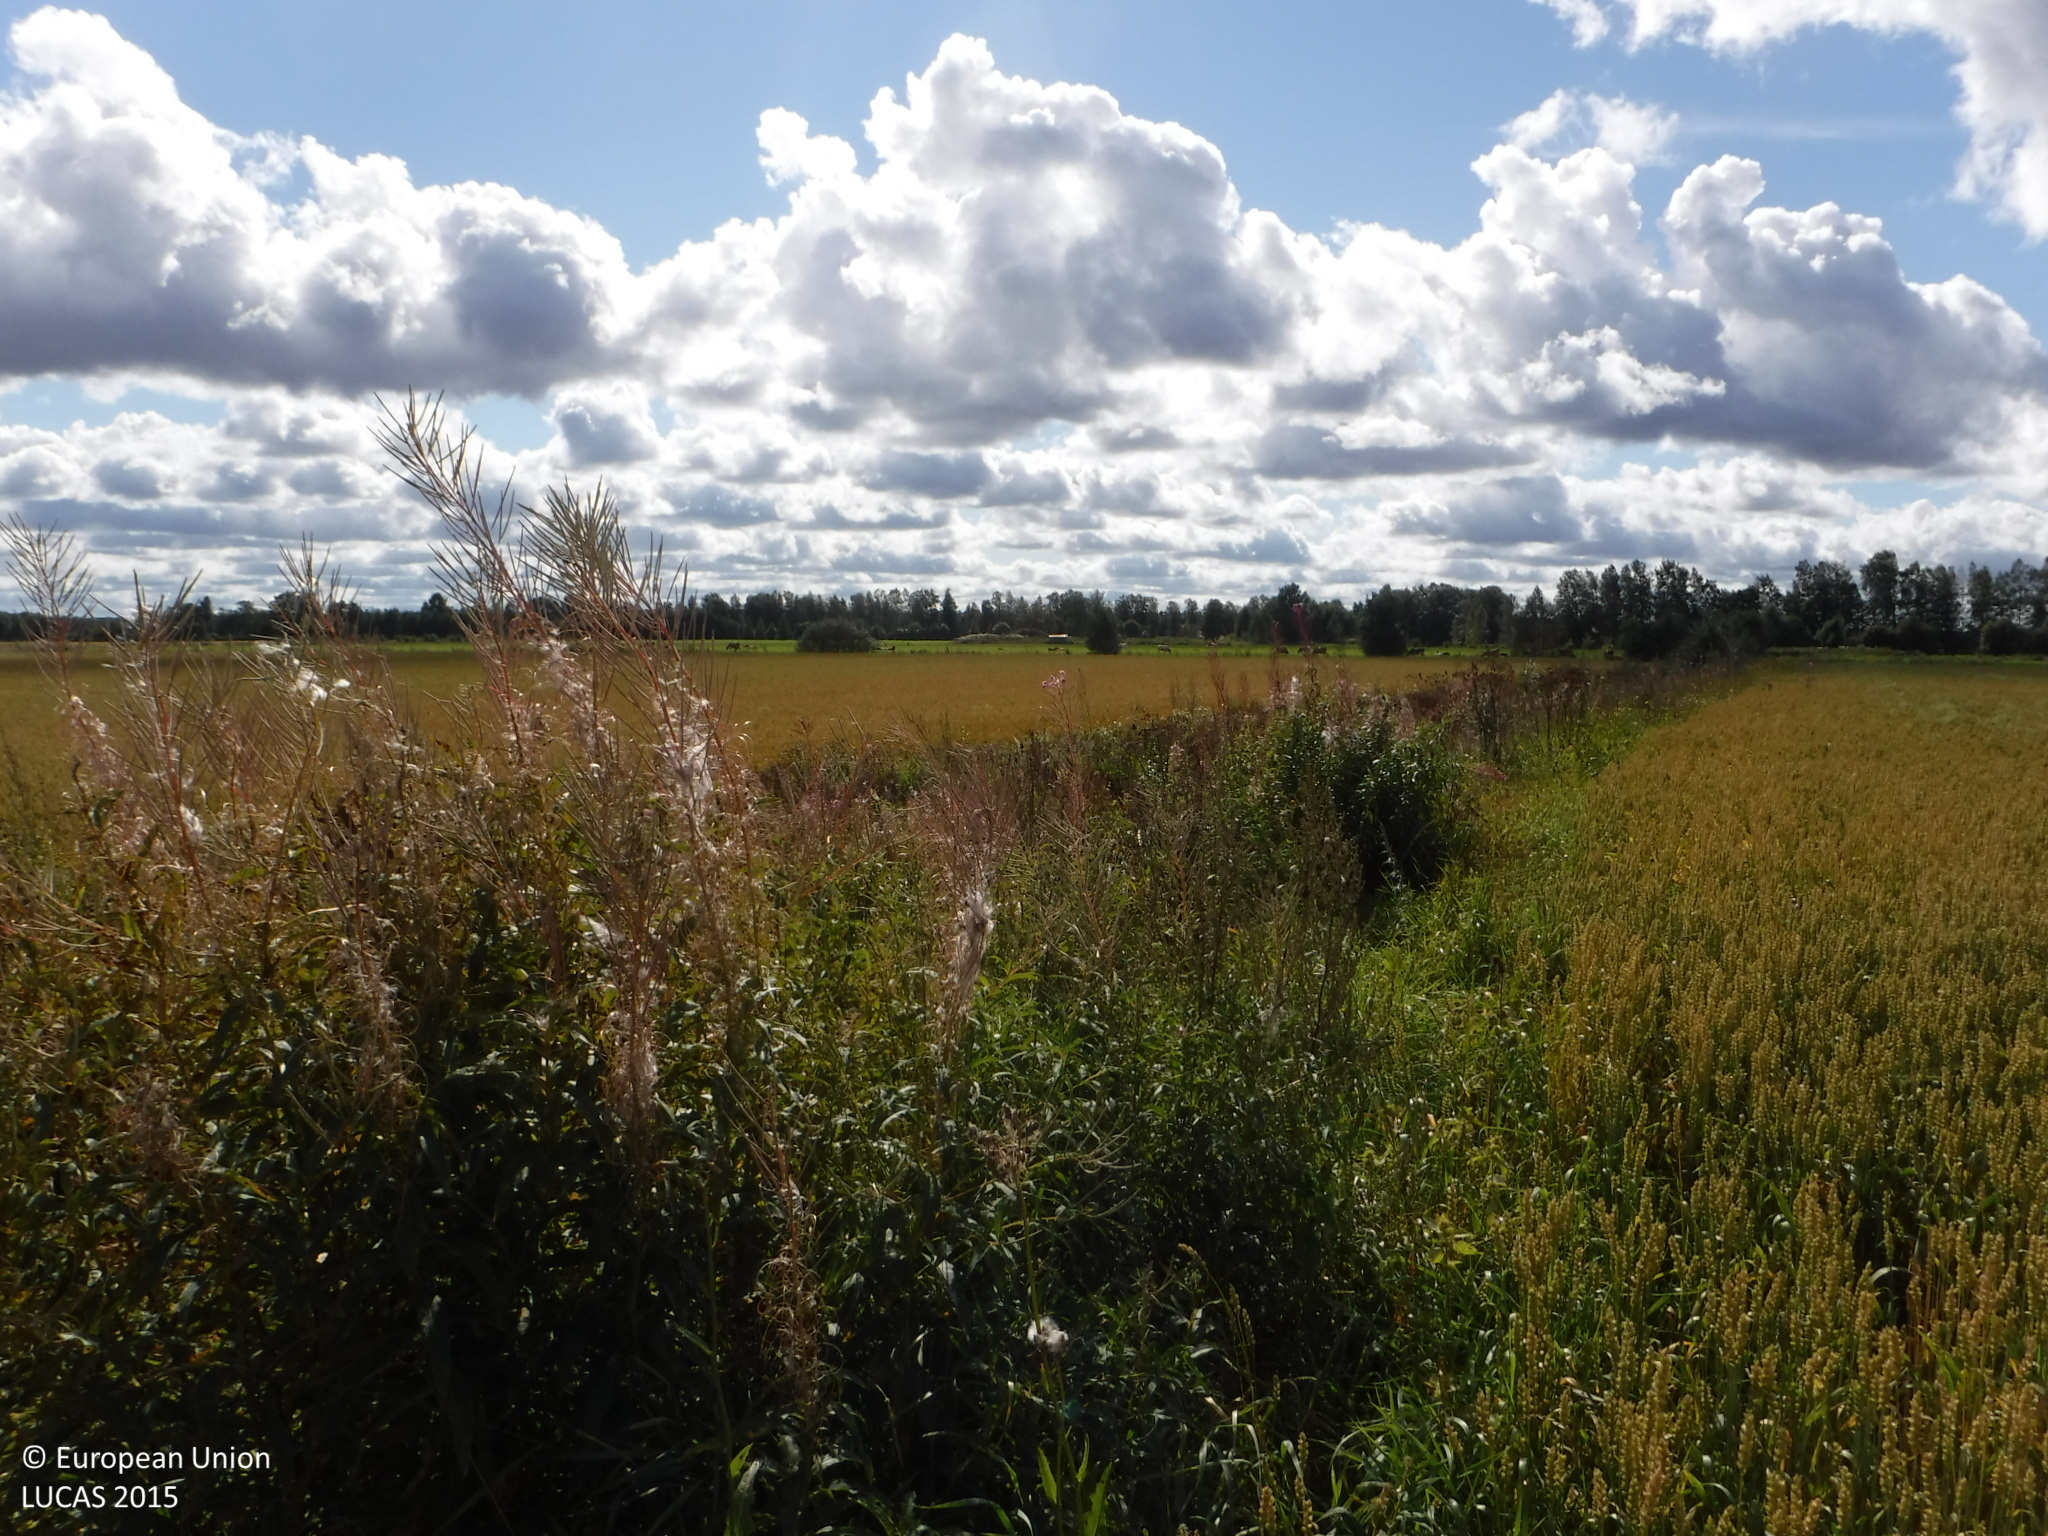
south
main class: Cropland
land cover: Common wheat
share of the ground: > 75 %
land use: Agriculture (excluding fallow land and kitchen gardens)
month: August
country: FI
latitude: 61.2239
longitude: 21.9196
